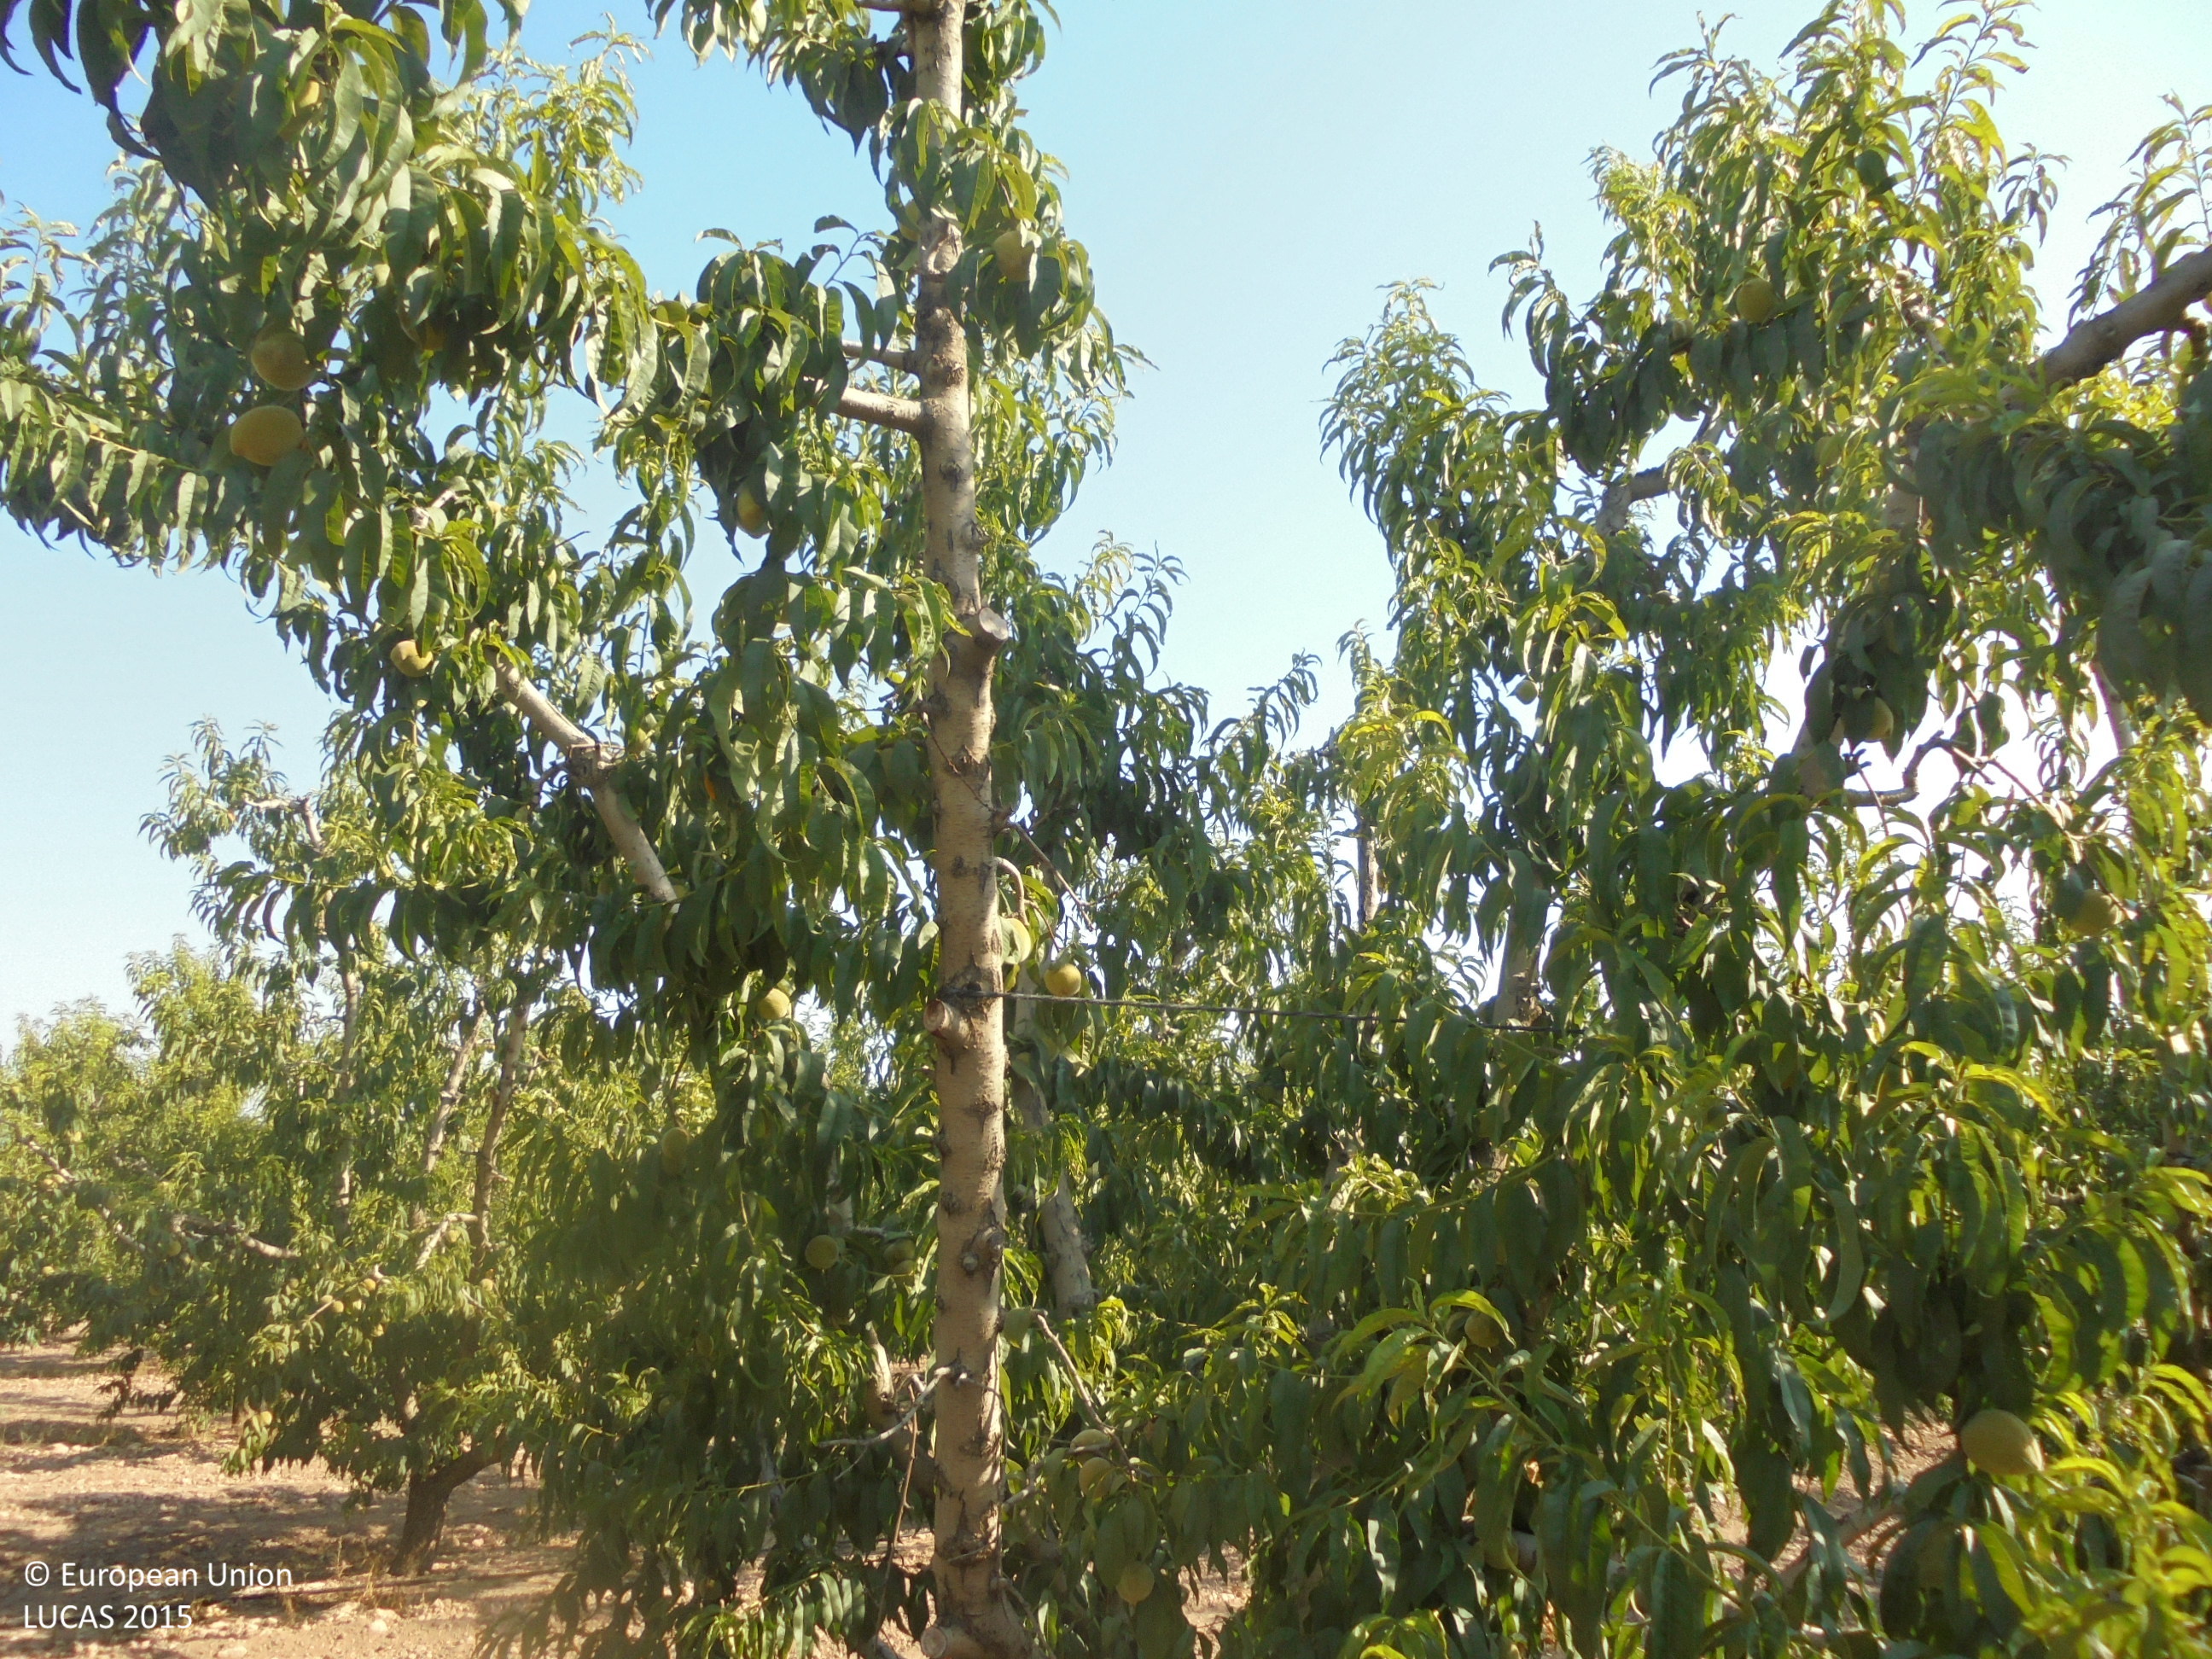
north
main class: Cropland
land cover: Other fruit trees and berries
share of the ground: > 75 %
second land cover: Other bare soil
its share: > 75 %
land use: Agriculture (excluding fallow land and kitchen gardens)
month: July
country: ES
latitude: 38.5500
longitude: -1.4783
